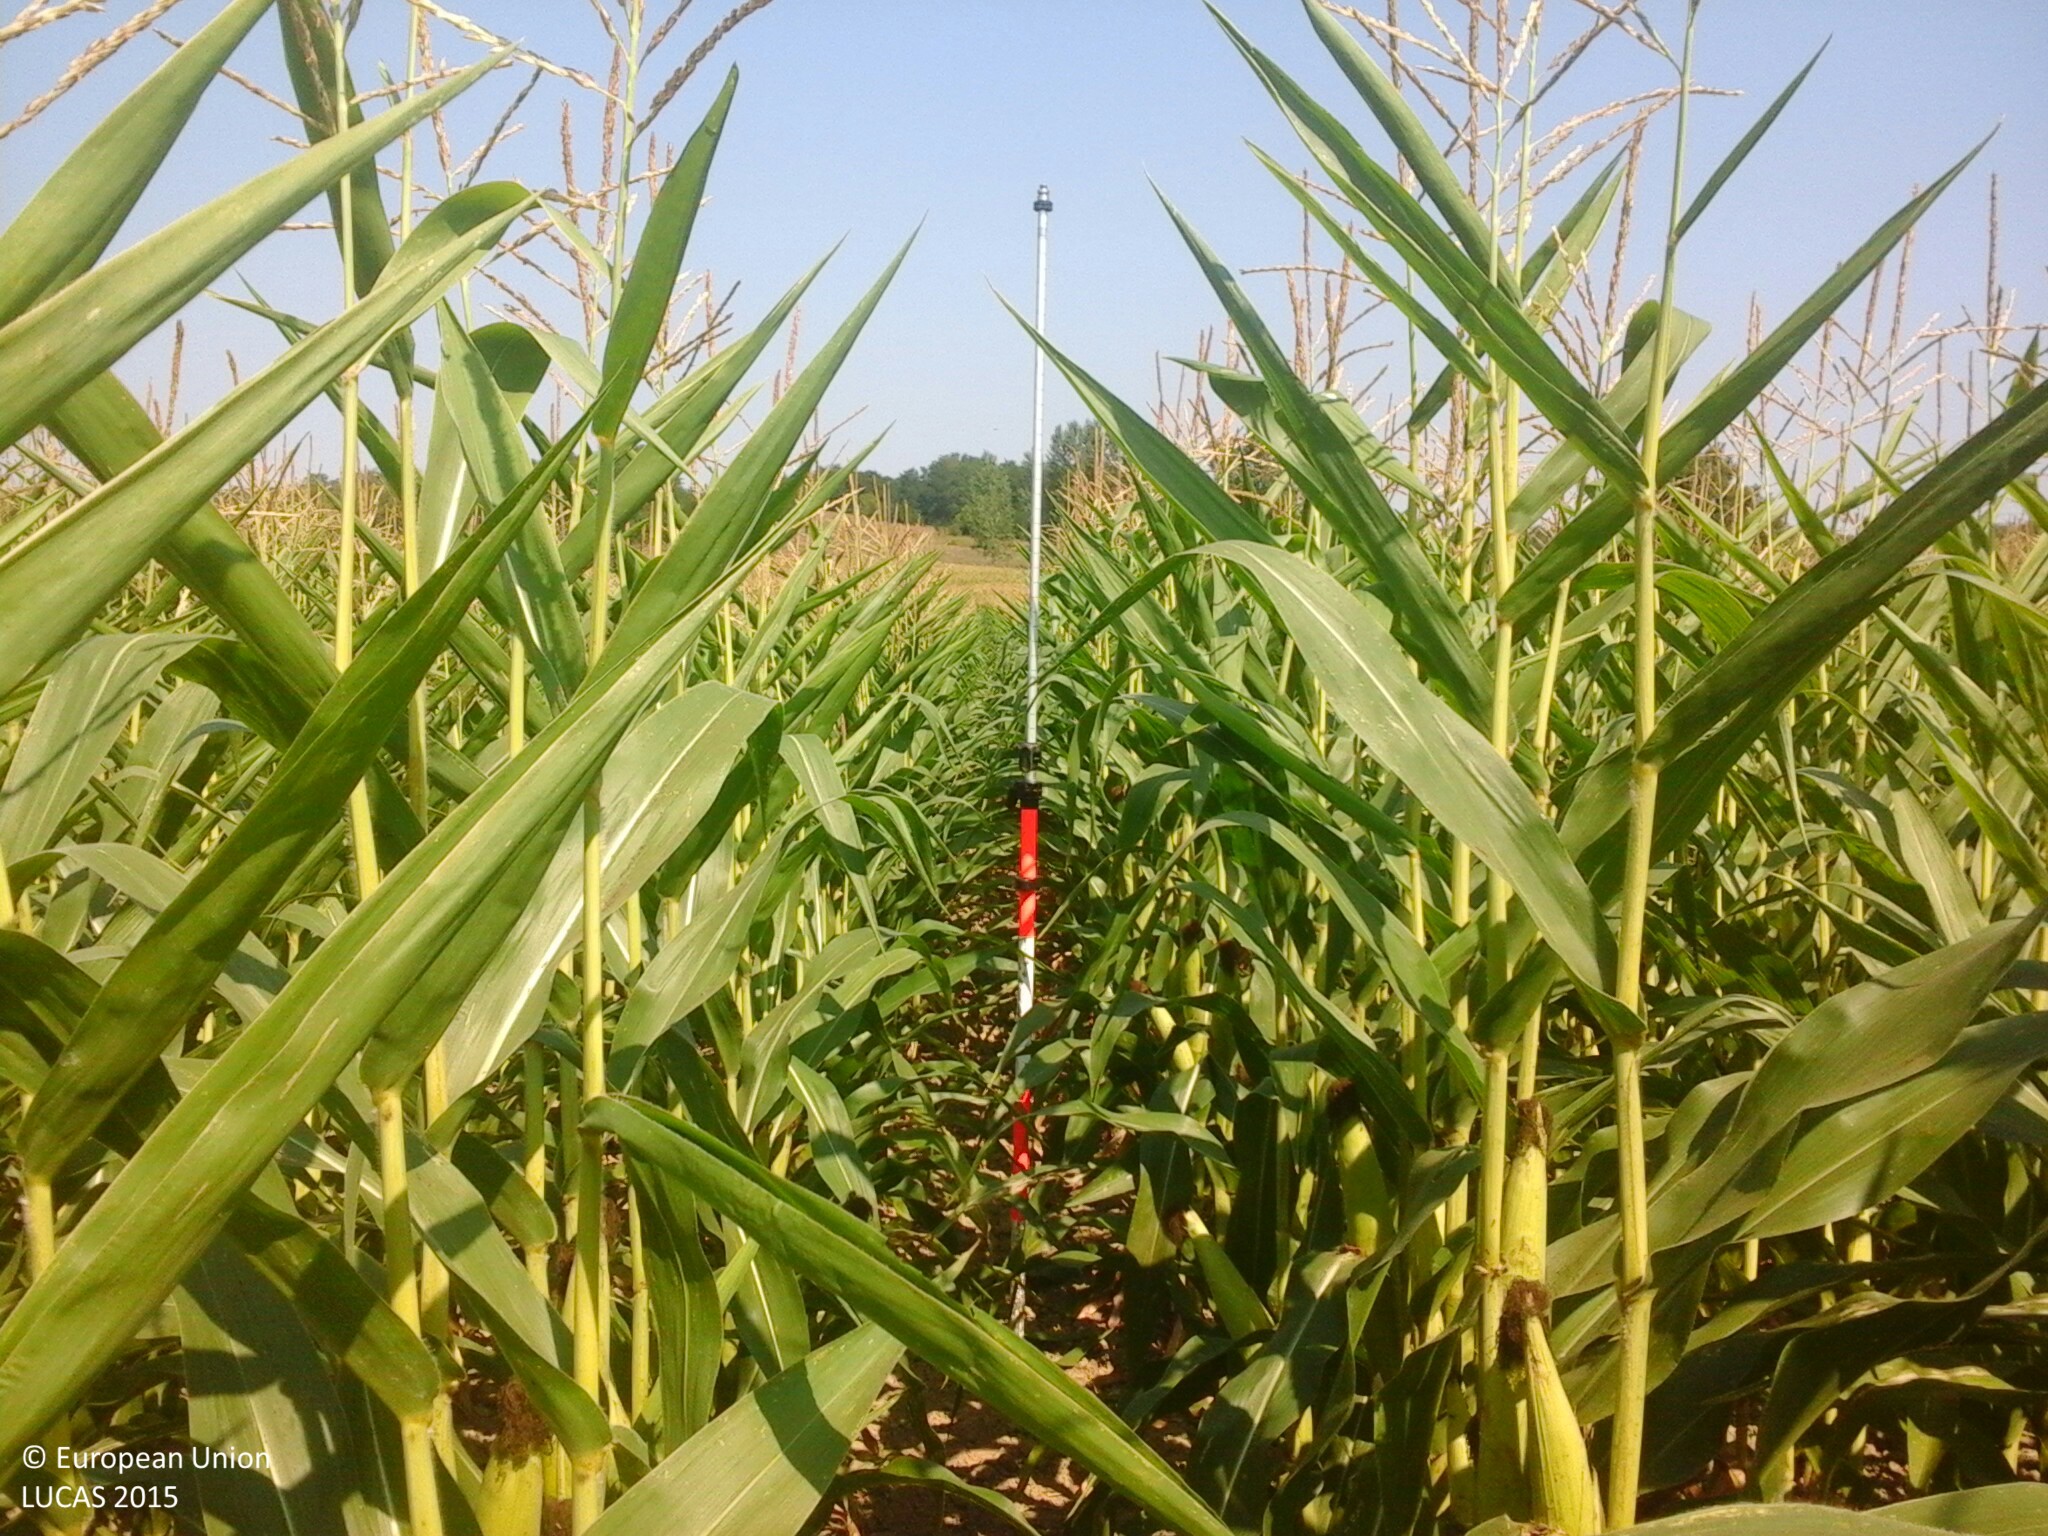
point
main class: Cropland
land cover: Maize
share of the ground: > 75 %
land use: Agriculture (excluding fallow land and kitchen gardens)
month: August
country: HU
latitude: 47.3644
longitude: 18.1013
